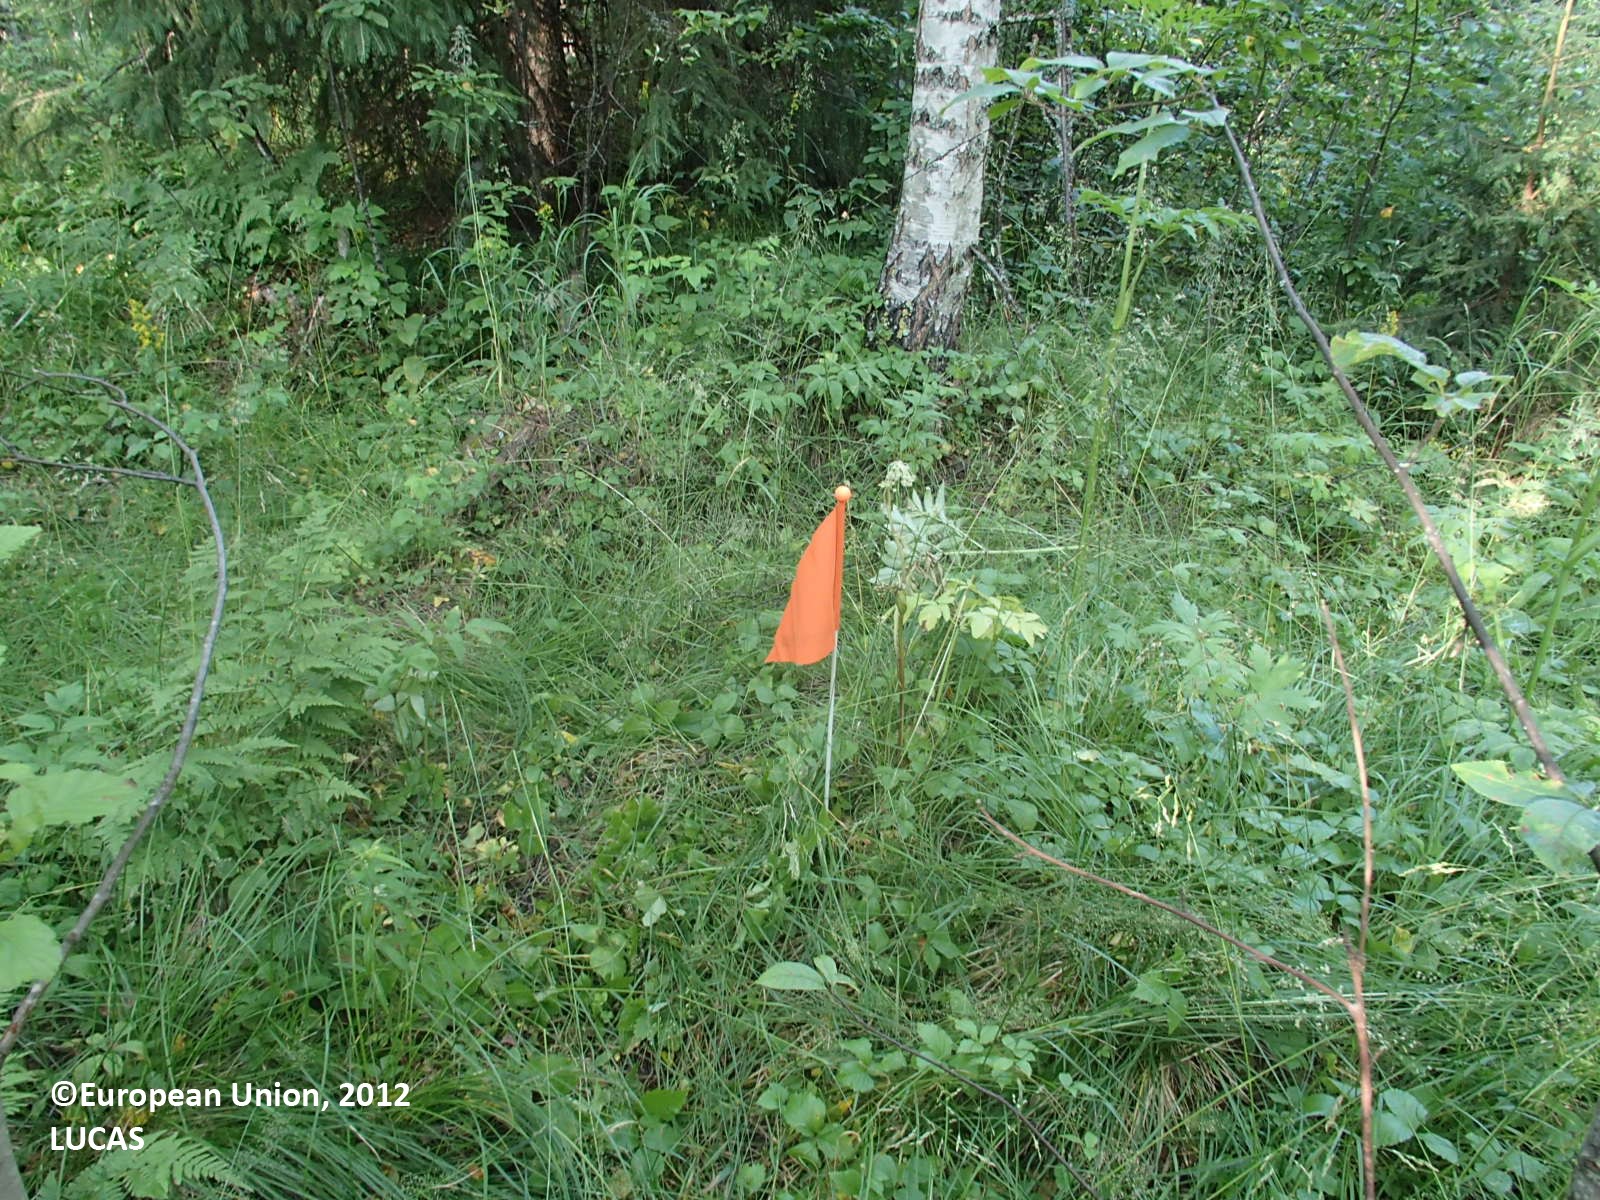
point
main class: Woodland
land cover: Spruce dominated mixed woodland
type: boreal forest
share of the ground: > 75 %
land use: Forestry
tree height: > 5 m
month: July
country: FI
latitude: 63.8944
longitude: 27.3584
